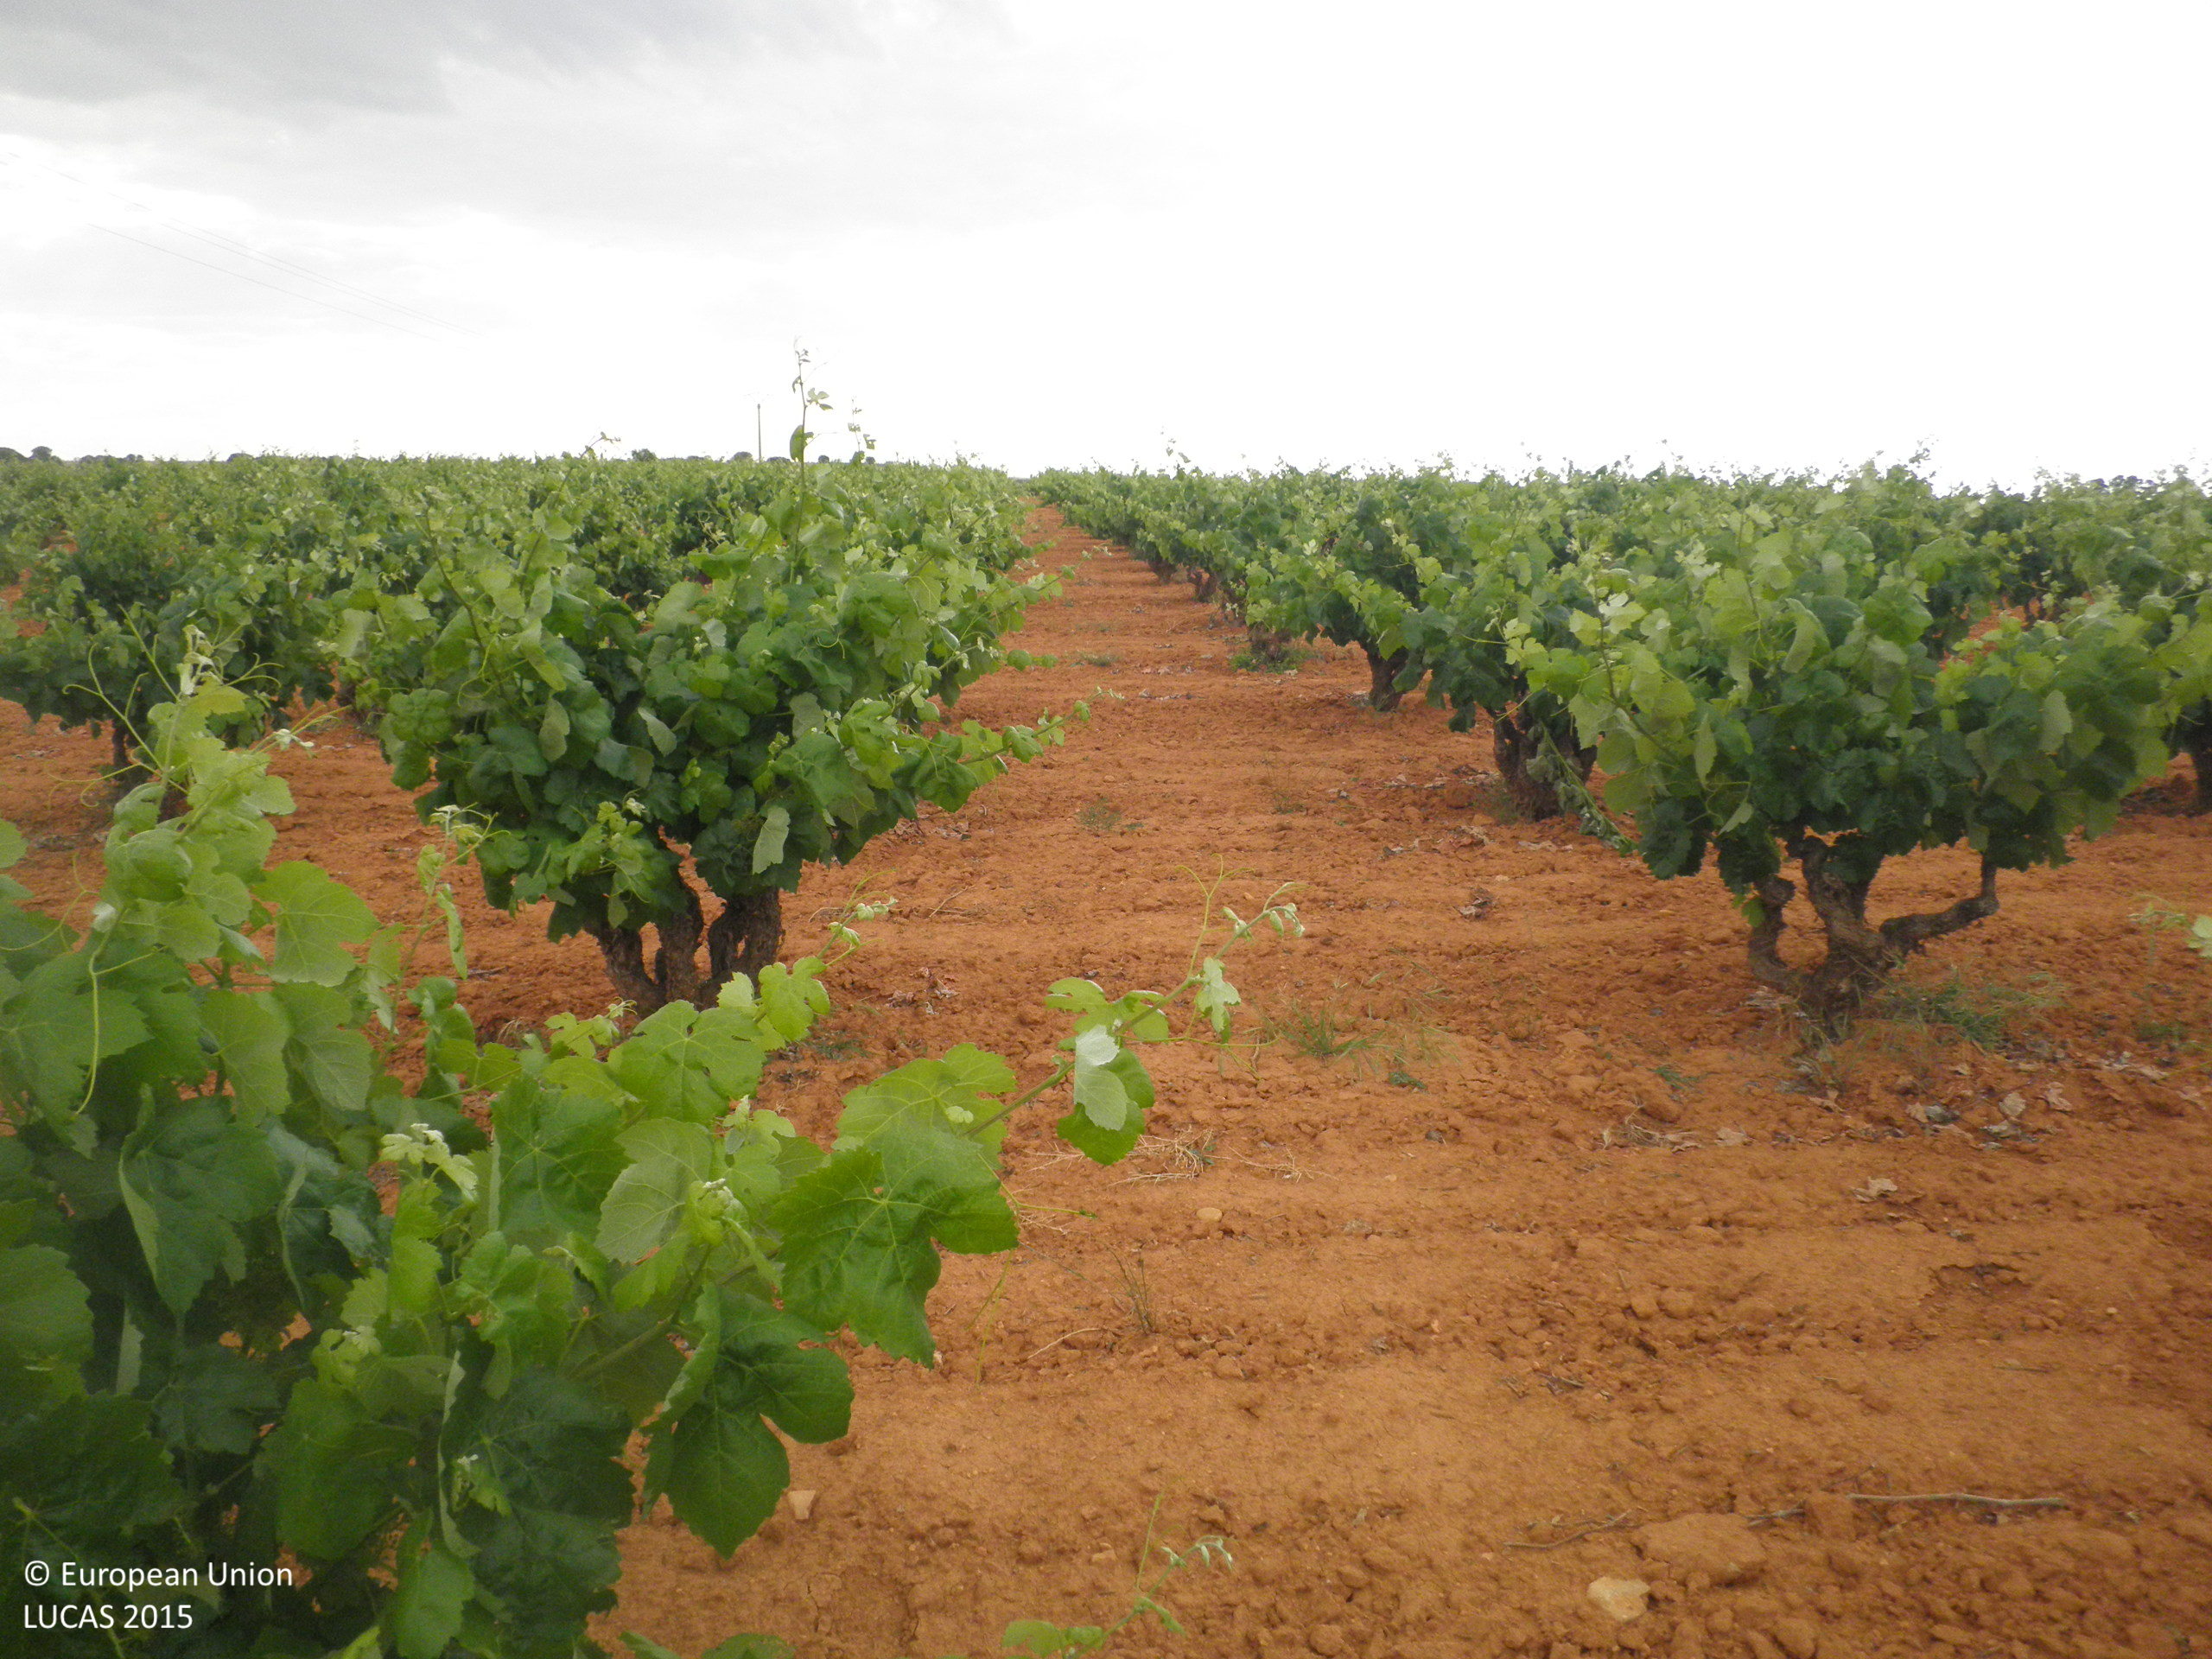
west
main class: Cropland
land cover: Vineyards
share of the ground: 10 - 25 %
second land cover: Other bare soil
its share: > 75 %
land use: Agriculture (excluding fallow land and kitchen gardens)
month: June
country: ES
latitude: 39.4430
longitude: -1.7993
